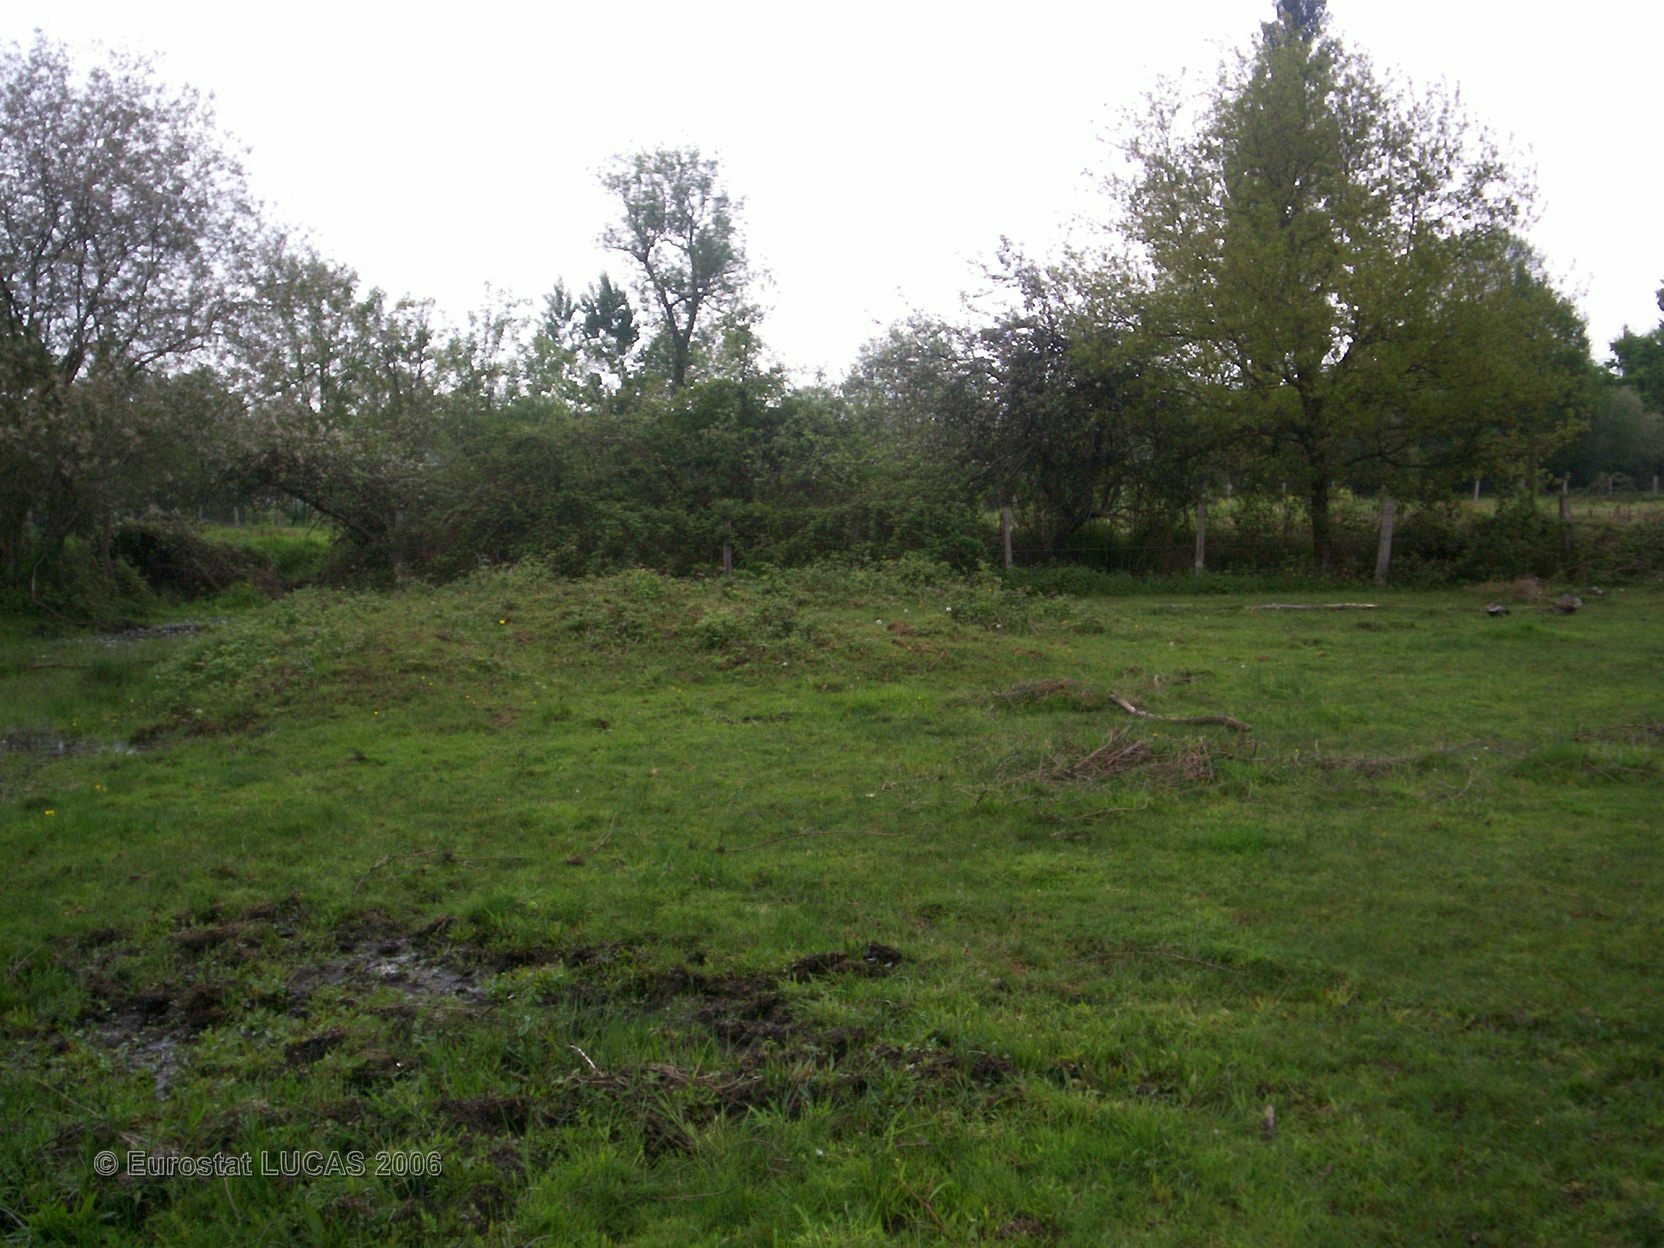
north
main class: Grassland
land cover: Grassland without tree/shrub cover
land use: Agriculture (excluding fallow land and kitchen gardens)
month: May
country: FR
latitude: 47.9573
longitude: 0.2929
